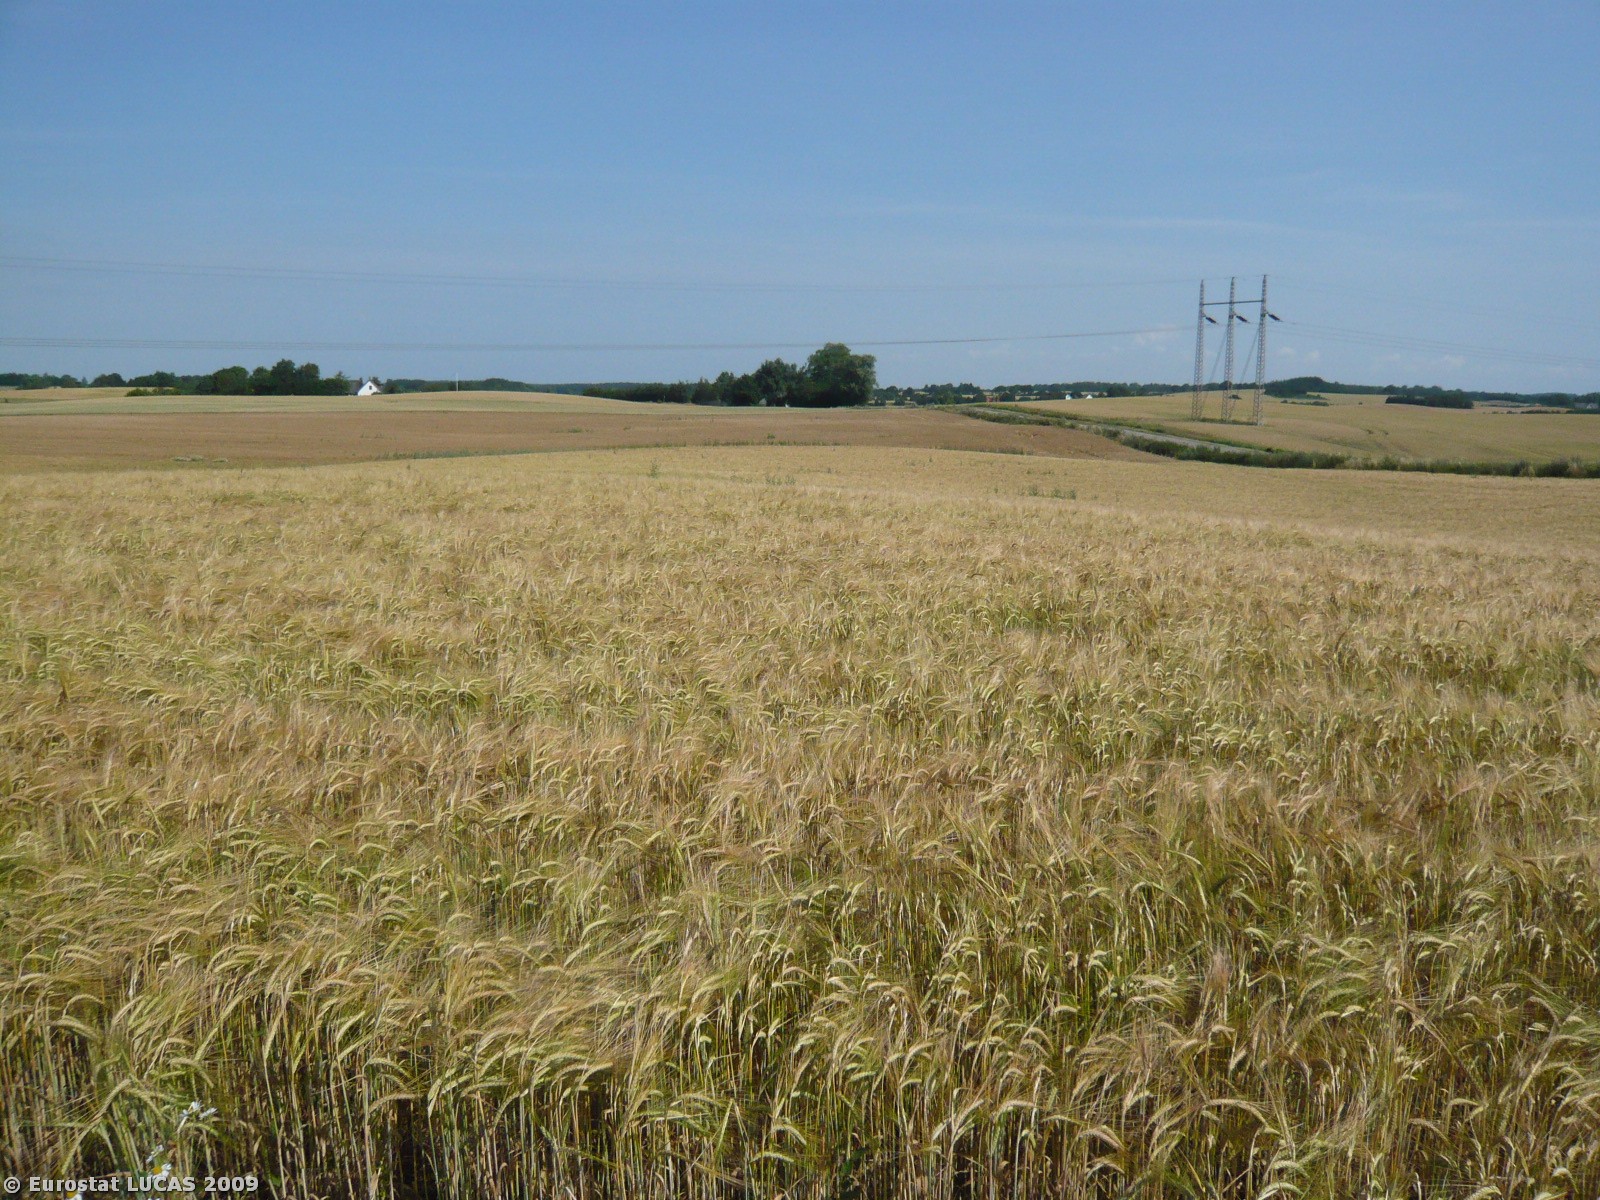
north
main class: Cropland
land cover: Barley
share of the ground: > 75 %
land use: Agriculture (excluding fallow land and kitchen gardens)
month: July
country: DK
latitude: 55.5815
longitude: 11.8227
